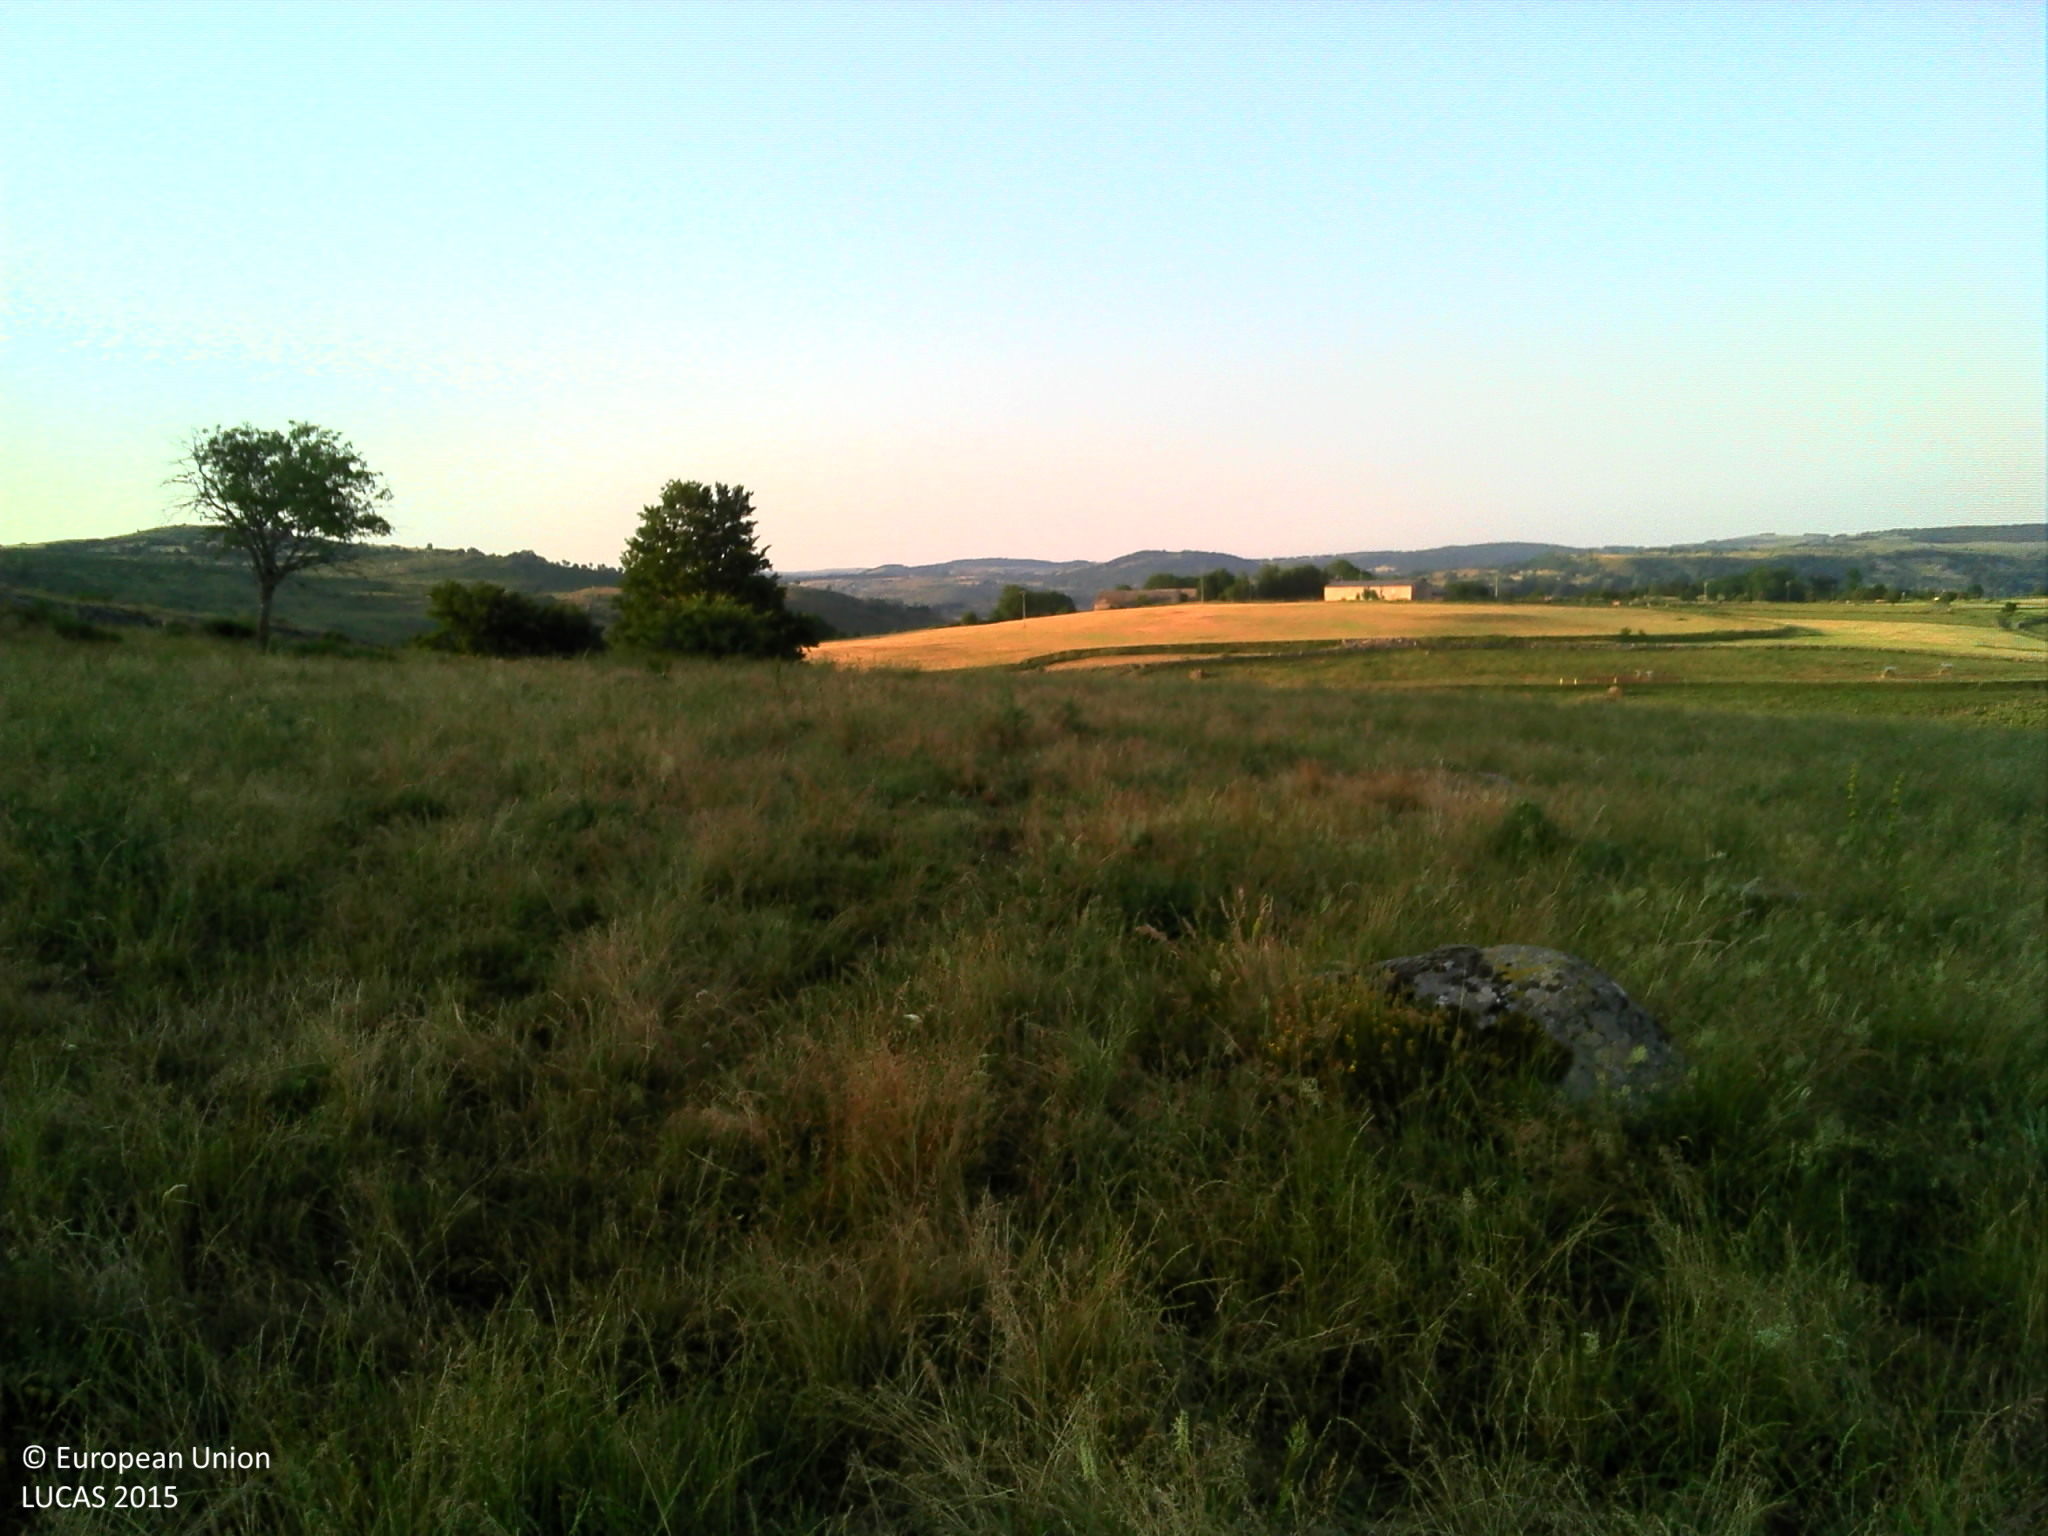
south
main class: Grassland
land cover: Grassland without tree/shrub cover
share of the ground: > 75 %
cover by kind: herbaceous plants 100 %
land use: Agriculture (excluding fallow land and kitchen gardens)
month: July
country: FR
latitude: 44.7306
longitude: 3.0206
